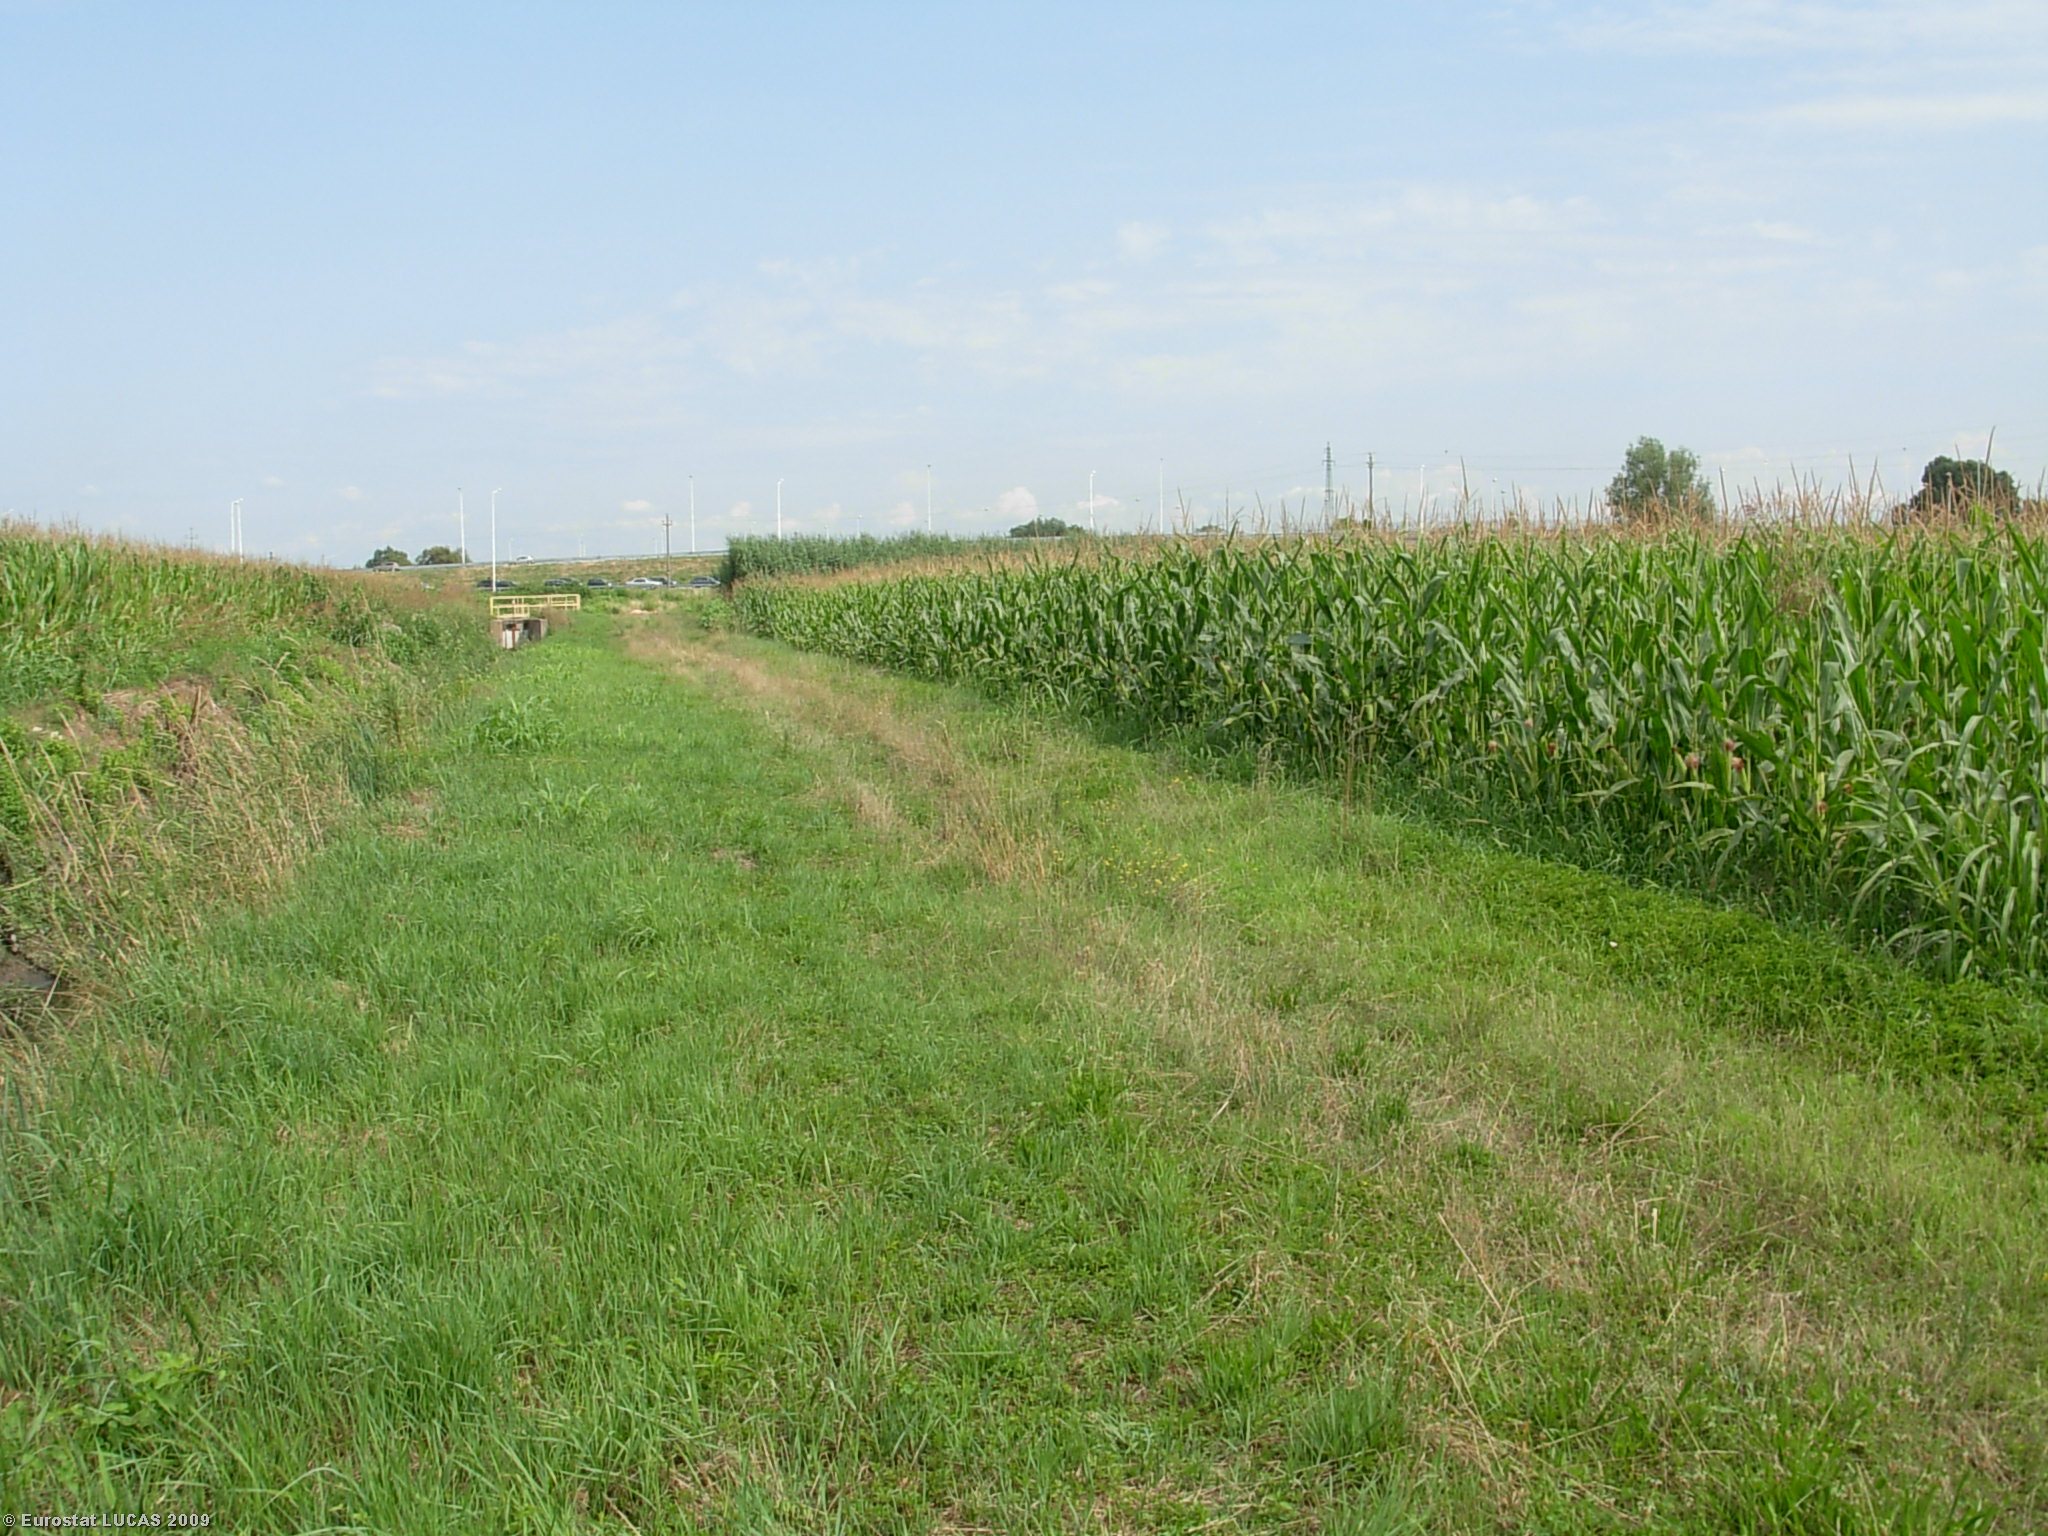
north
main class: Cropland
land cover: Maize
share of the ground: > 75 %
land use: Agriculture (excluding fallow land and kitchen gardens)
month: July
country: IT
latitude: 45.3757
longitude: 9.2734
